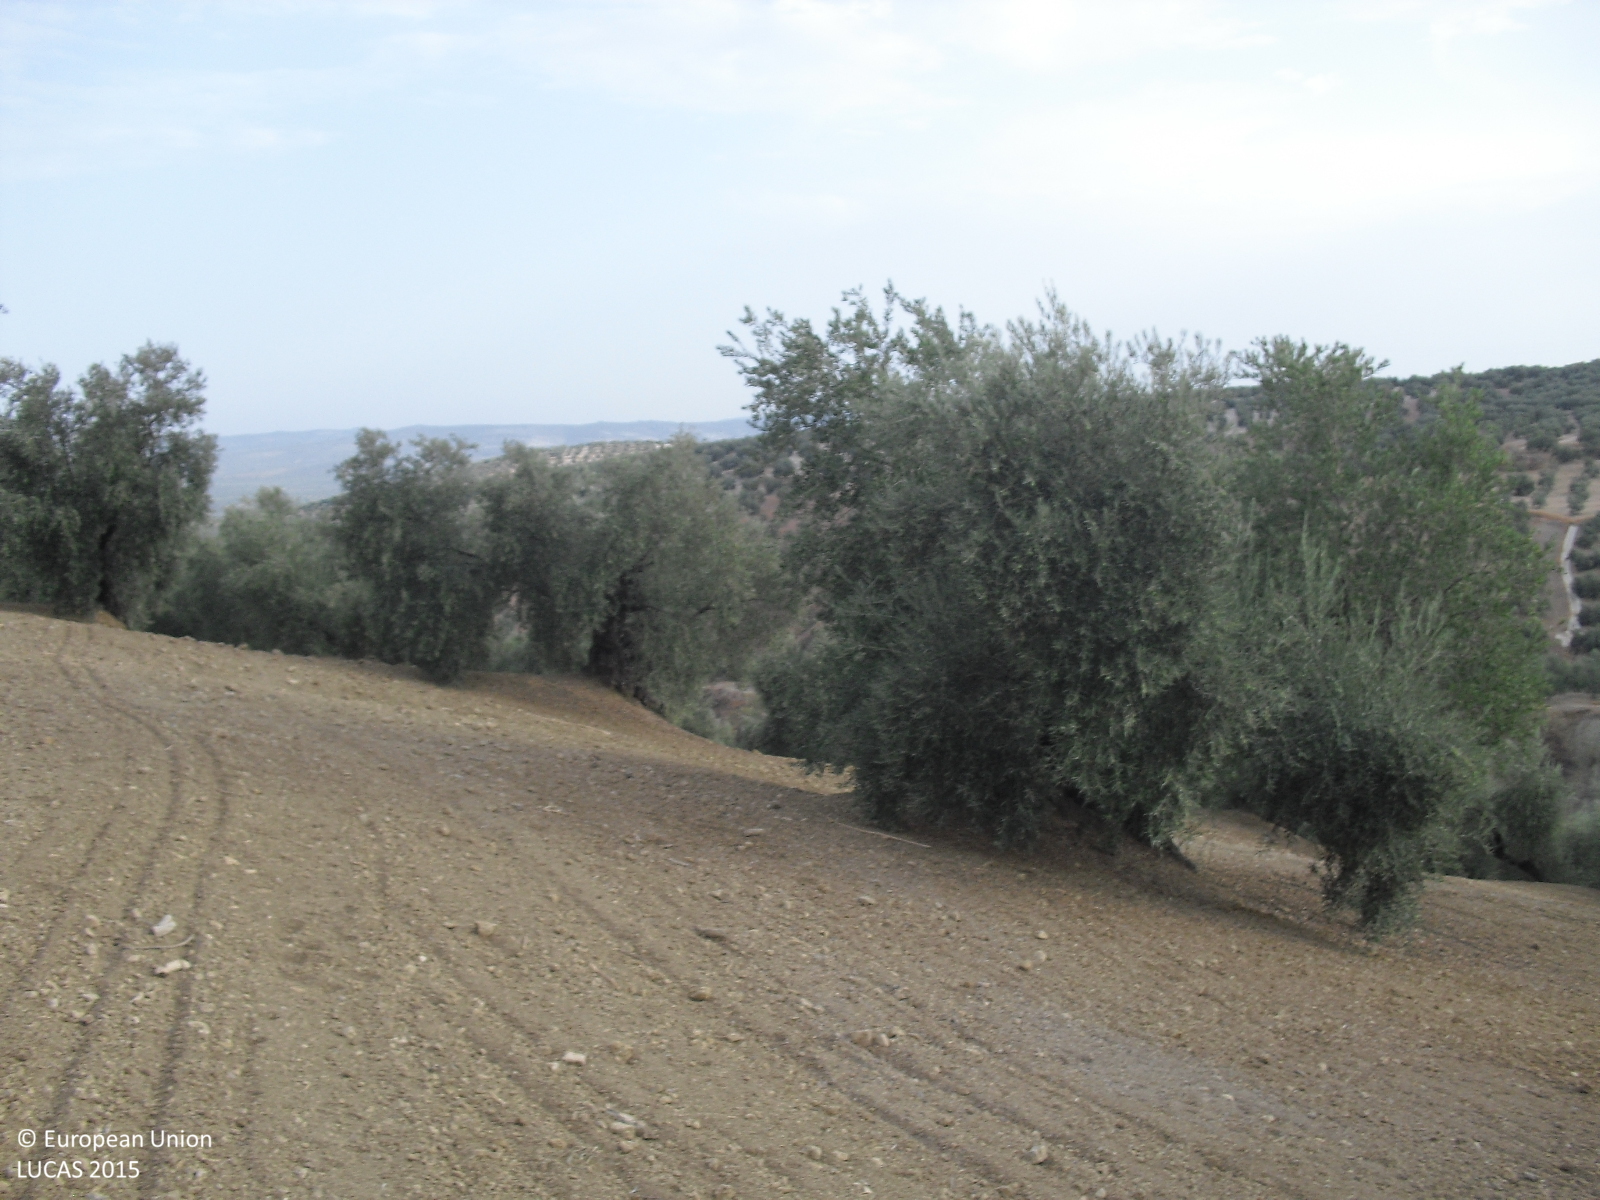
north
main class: Cropland
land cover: Olive groves
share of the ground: 25 - 50 %
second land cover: Other bare soil
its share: > 75 %
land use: Agriculture (excluding fallow land and kitchen gardens)
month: August
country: ES
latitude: 37.3273
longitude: -4.3892
